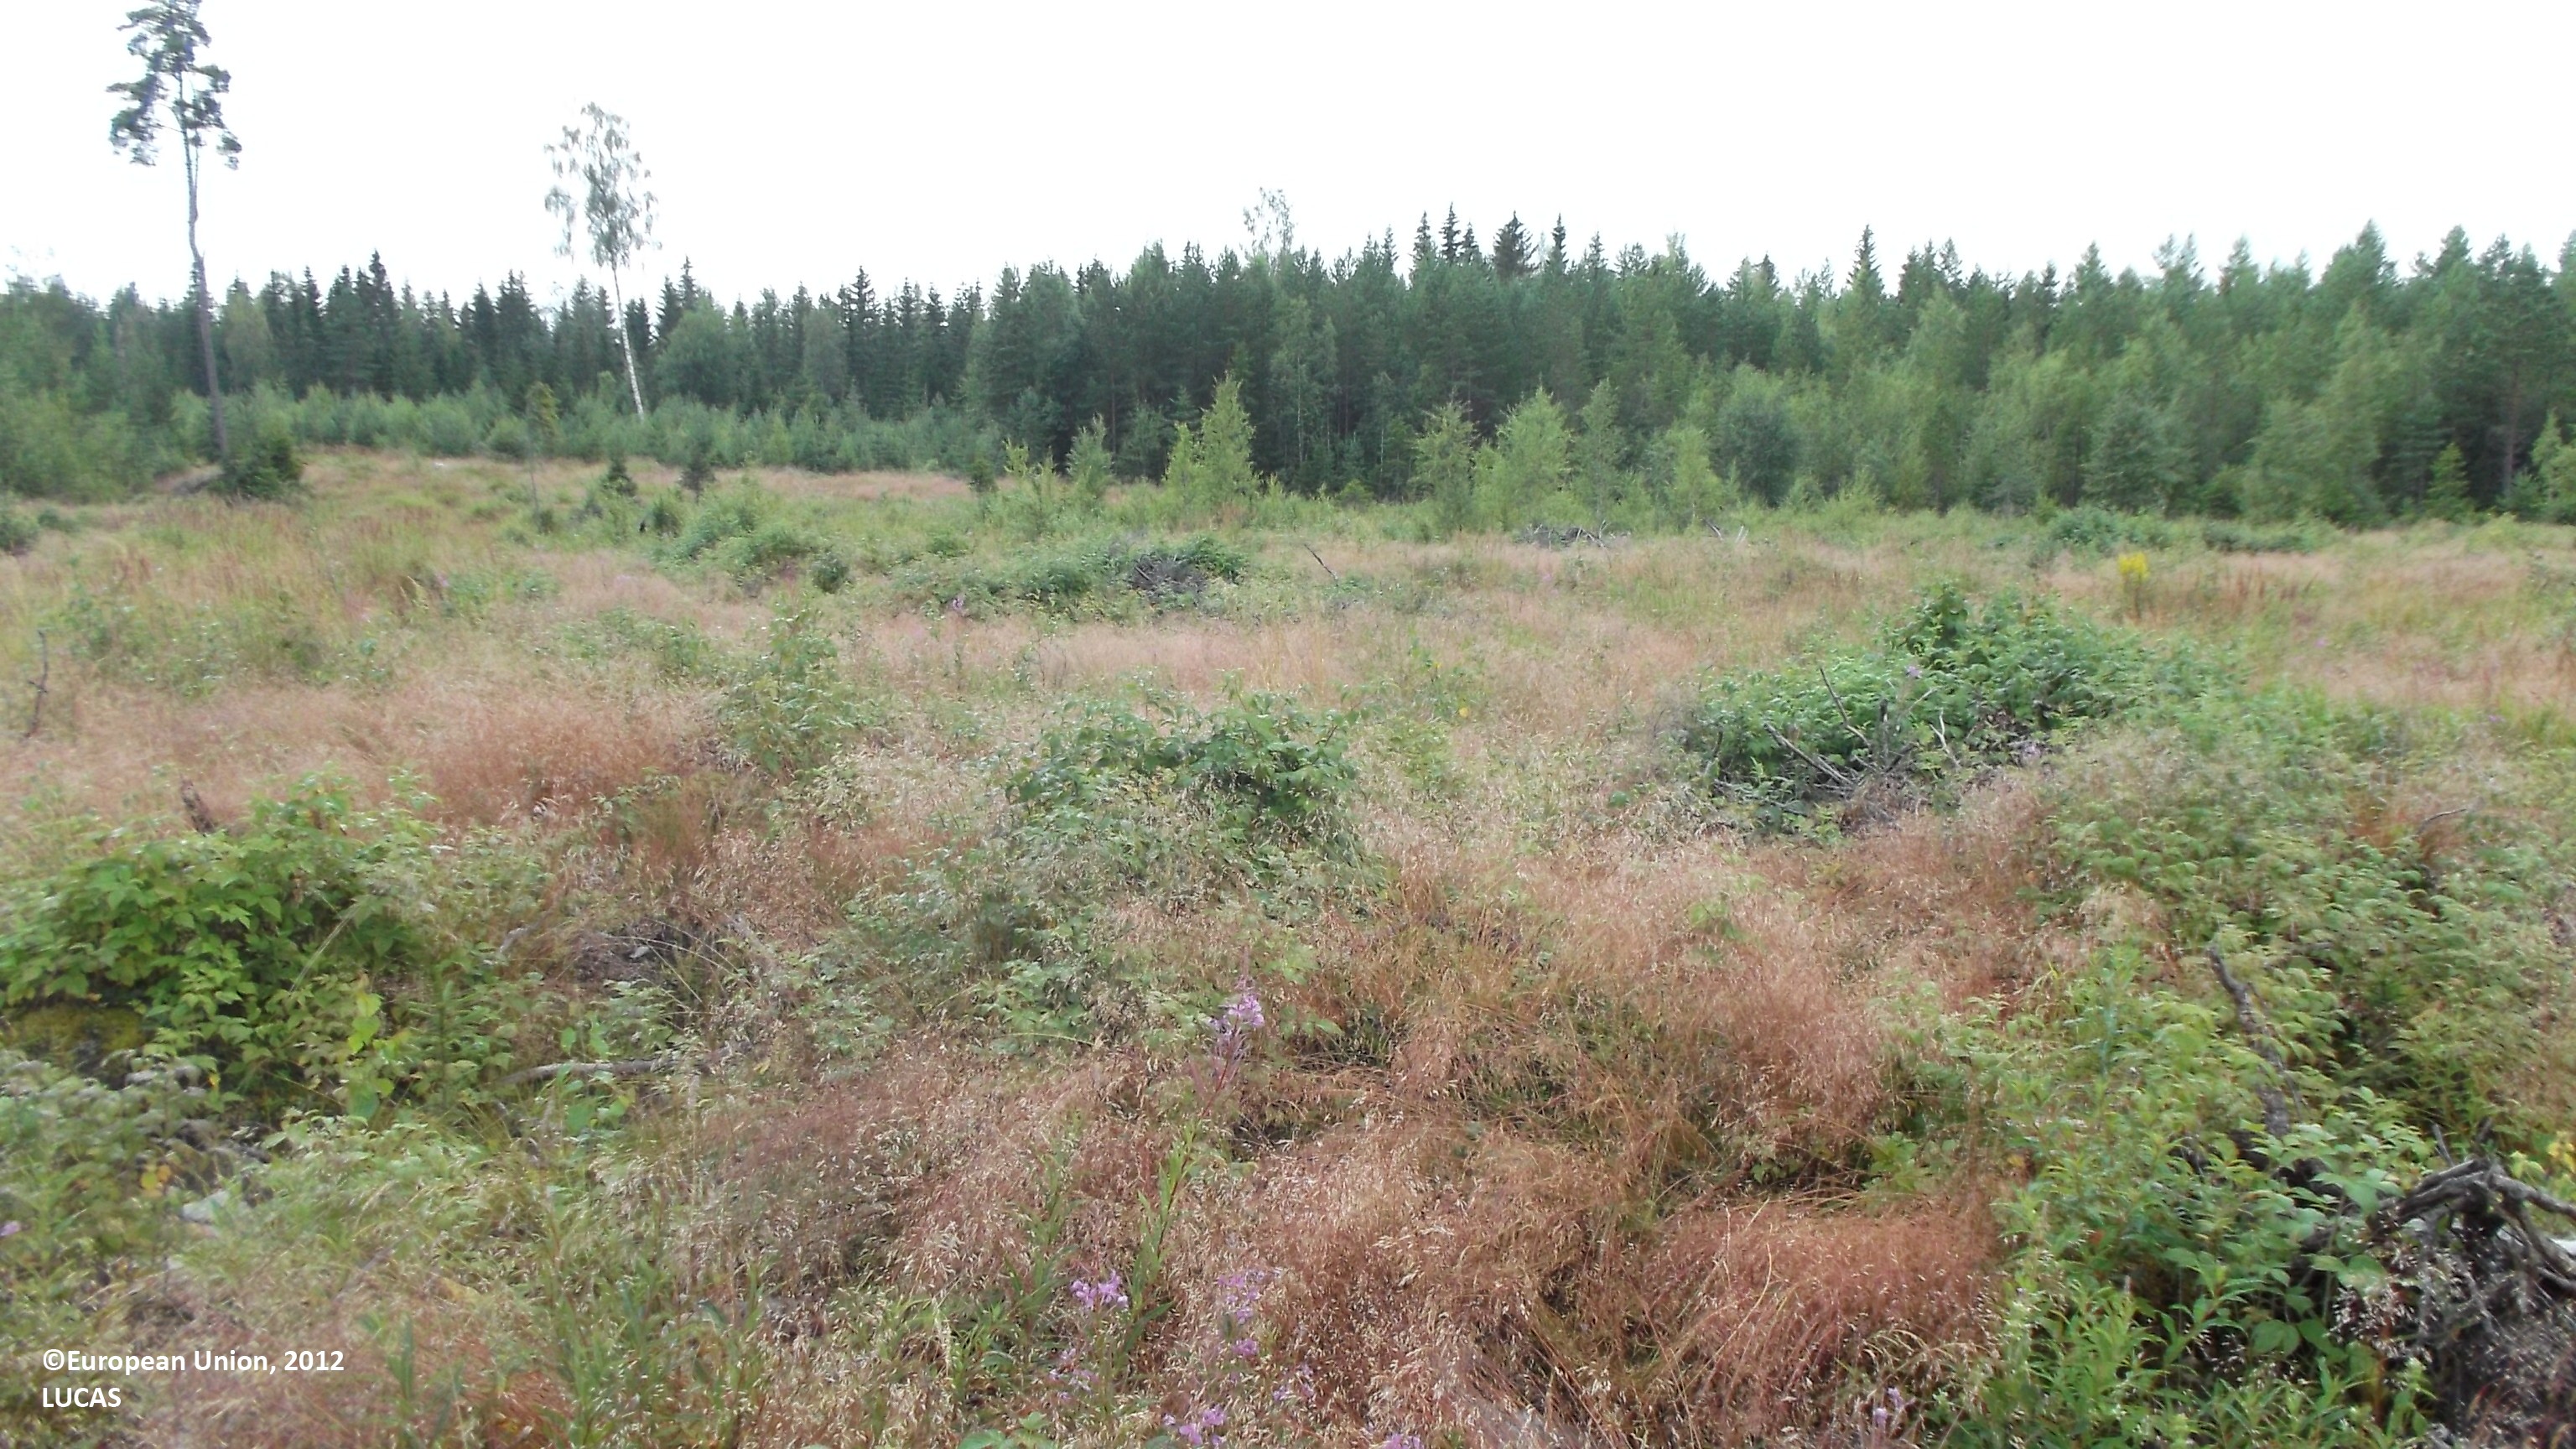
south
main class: Grassland
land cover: Grassland without tree/shrub cover
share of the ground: 50 - 75 %
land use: Forestry
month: August
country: FI
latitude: 63.8648
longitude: 23.3842
